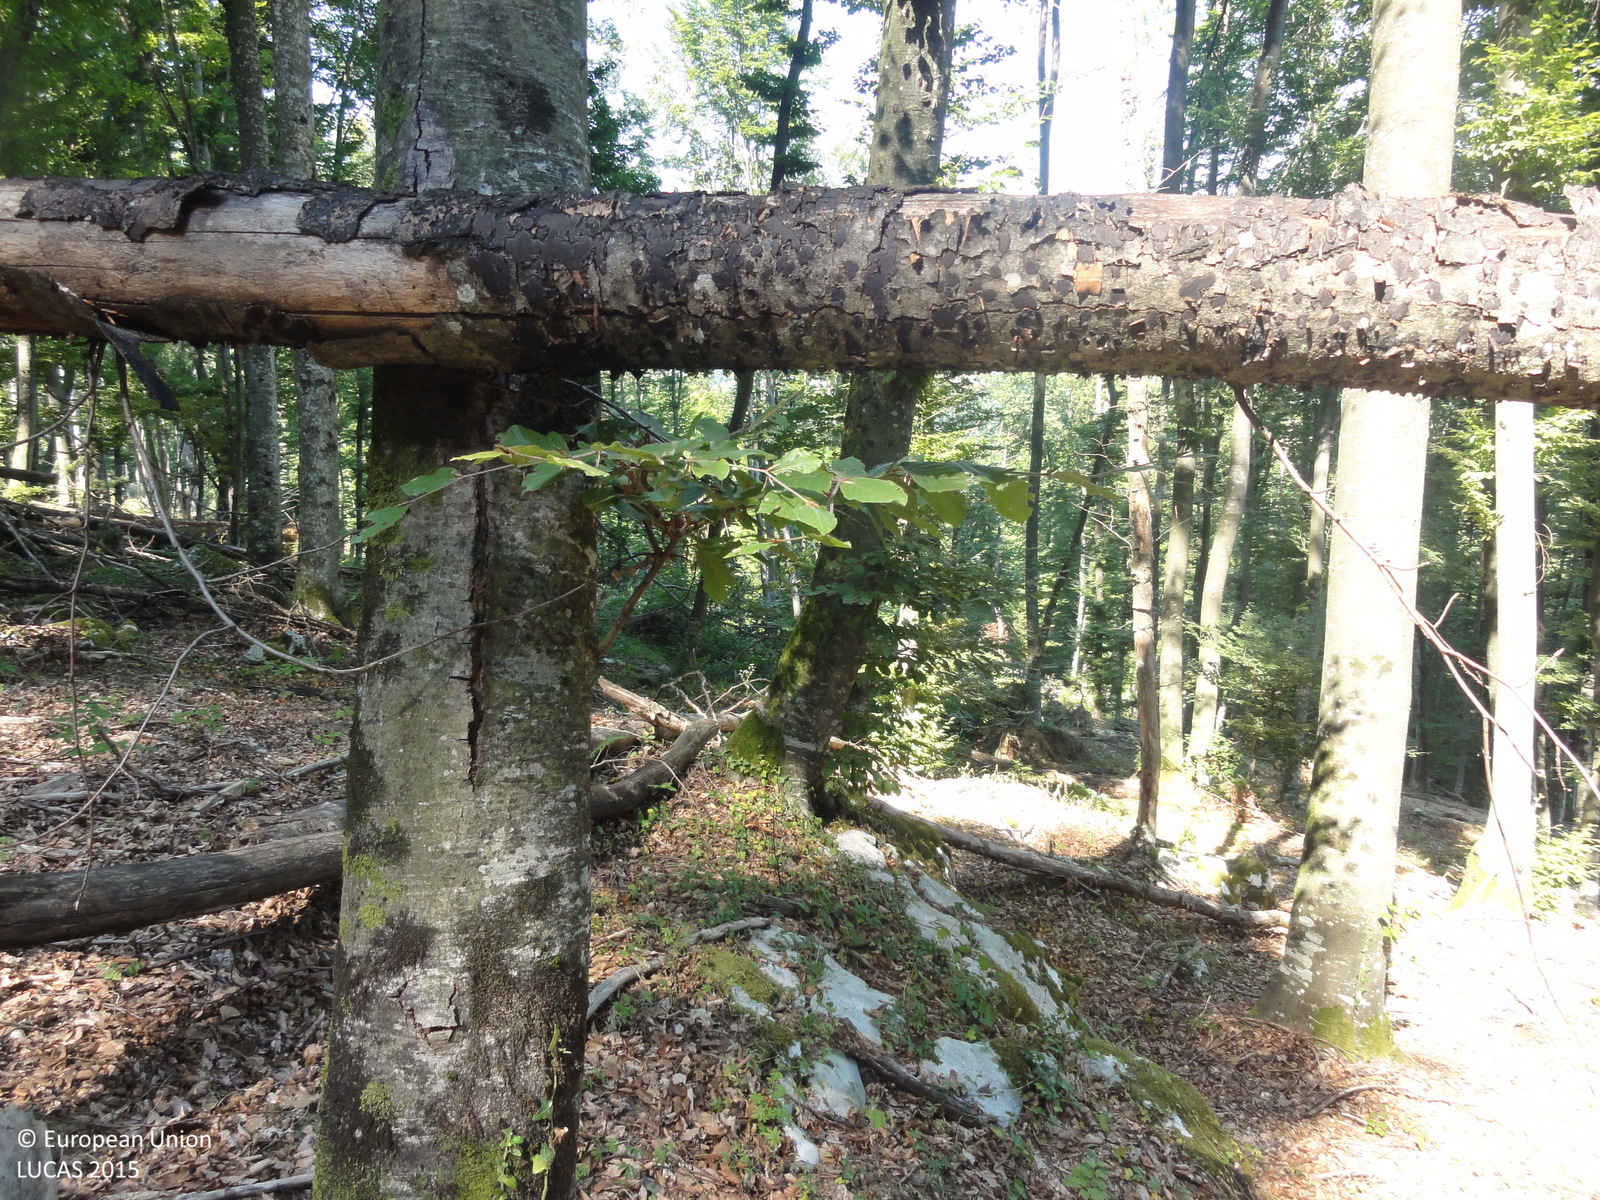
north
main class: Woodland
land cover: Broadleaved woodland
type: beech forest
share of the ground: > 75 %
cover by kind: broadleaved forest trees 80 %, herbaceous plants 15 %, consolidated bare surface 5 %
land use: Forestry
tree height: > 5 m
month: August
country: SI
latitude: 45.8538
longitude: 15.0320
